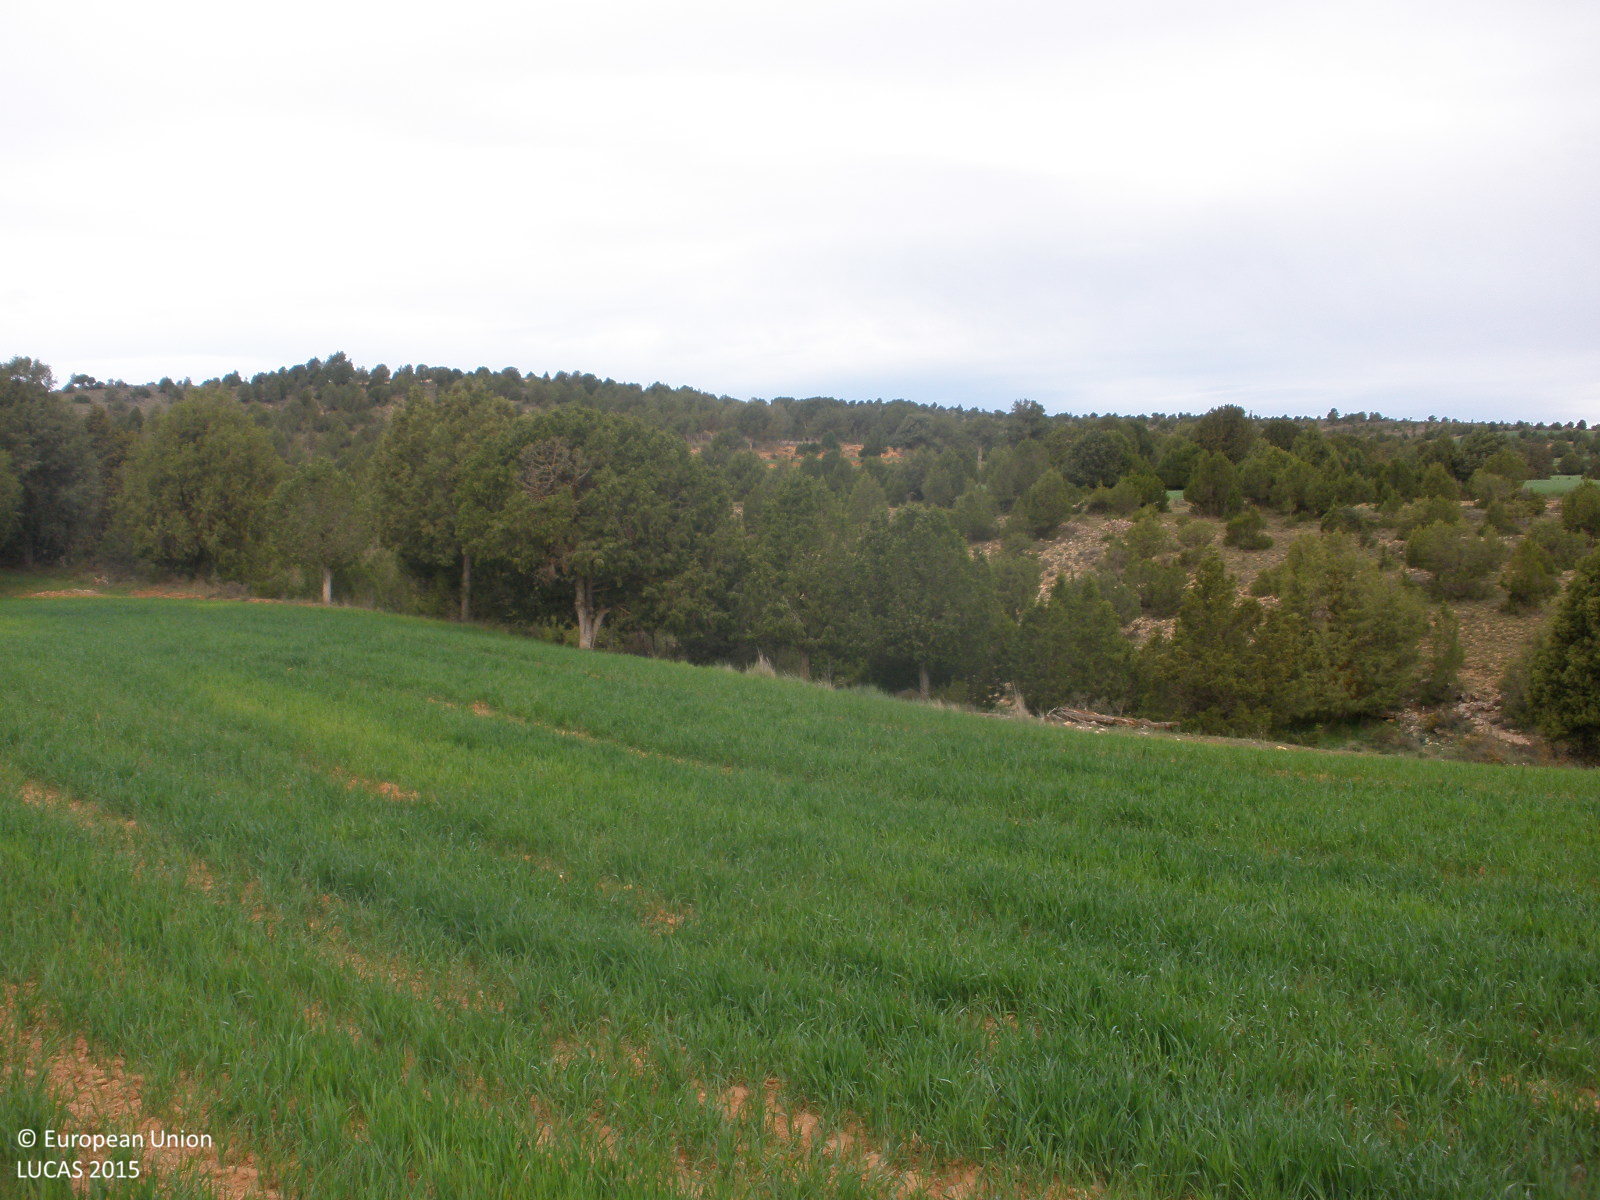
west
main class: Cropland
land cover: Barley
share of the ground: > 75 %
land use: Agriculture (excluding fallow land and kitchen gardens)
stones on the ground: < 10 %
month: May
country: ES
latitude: 40.4124
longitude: -1.0055
